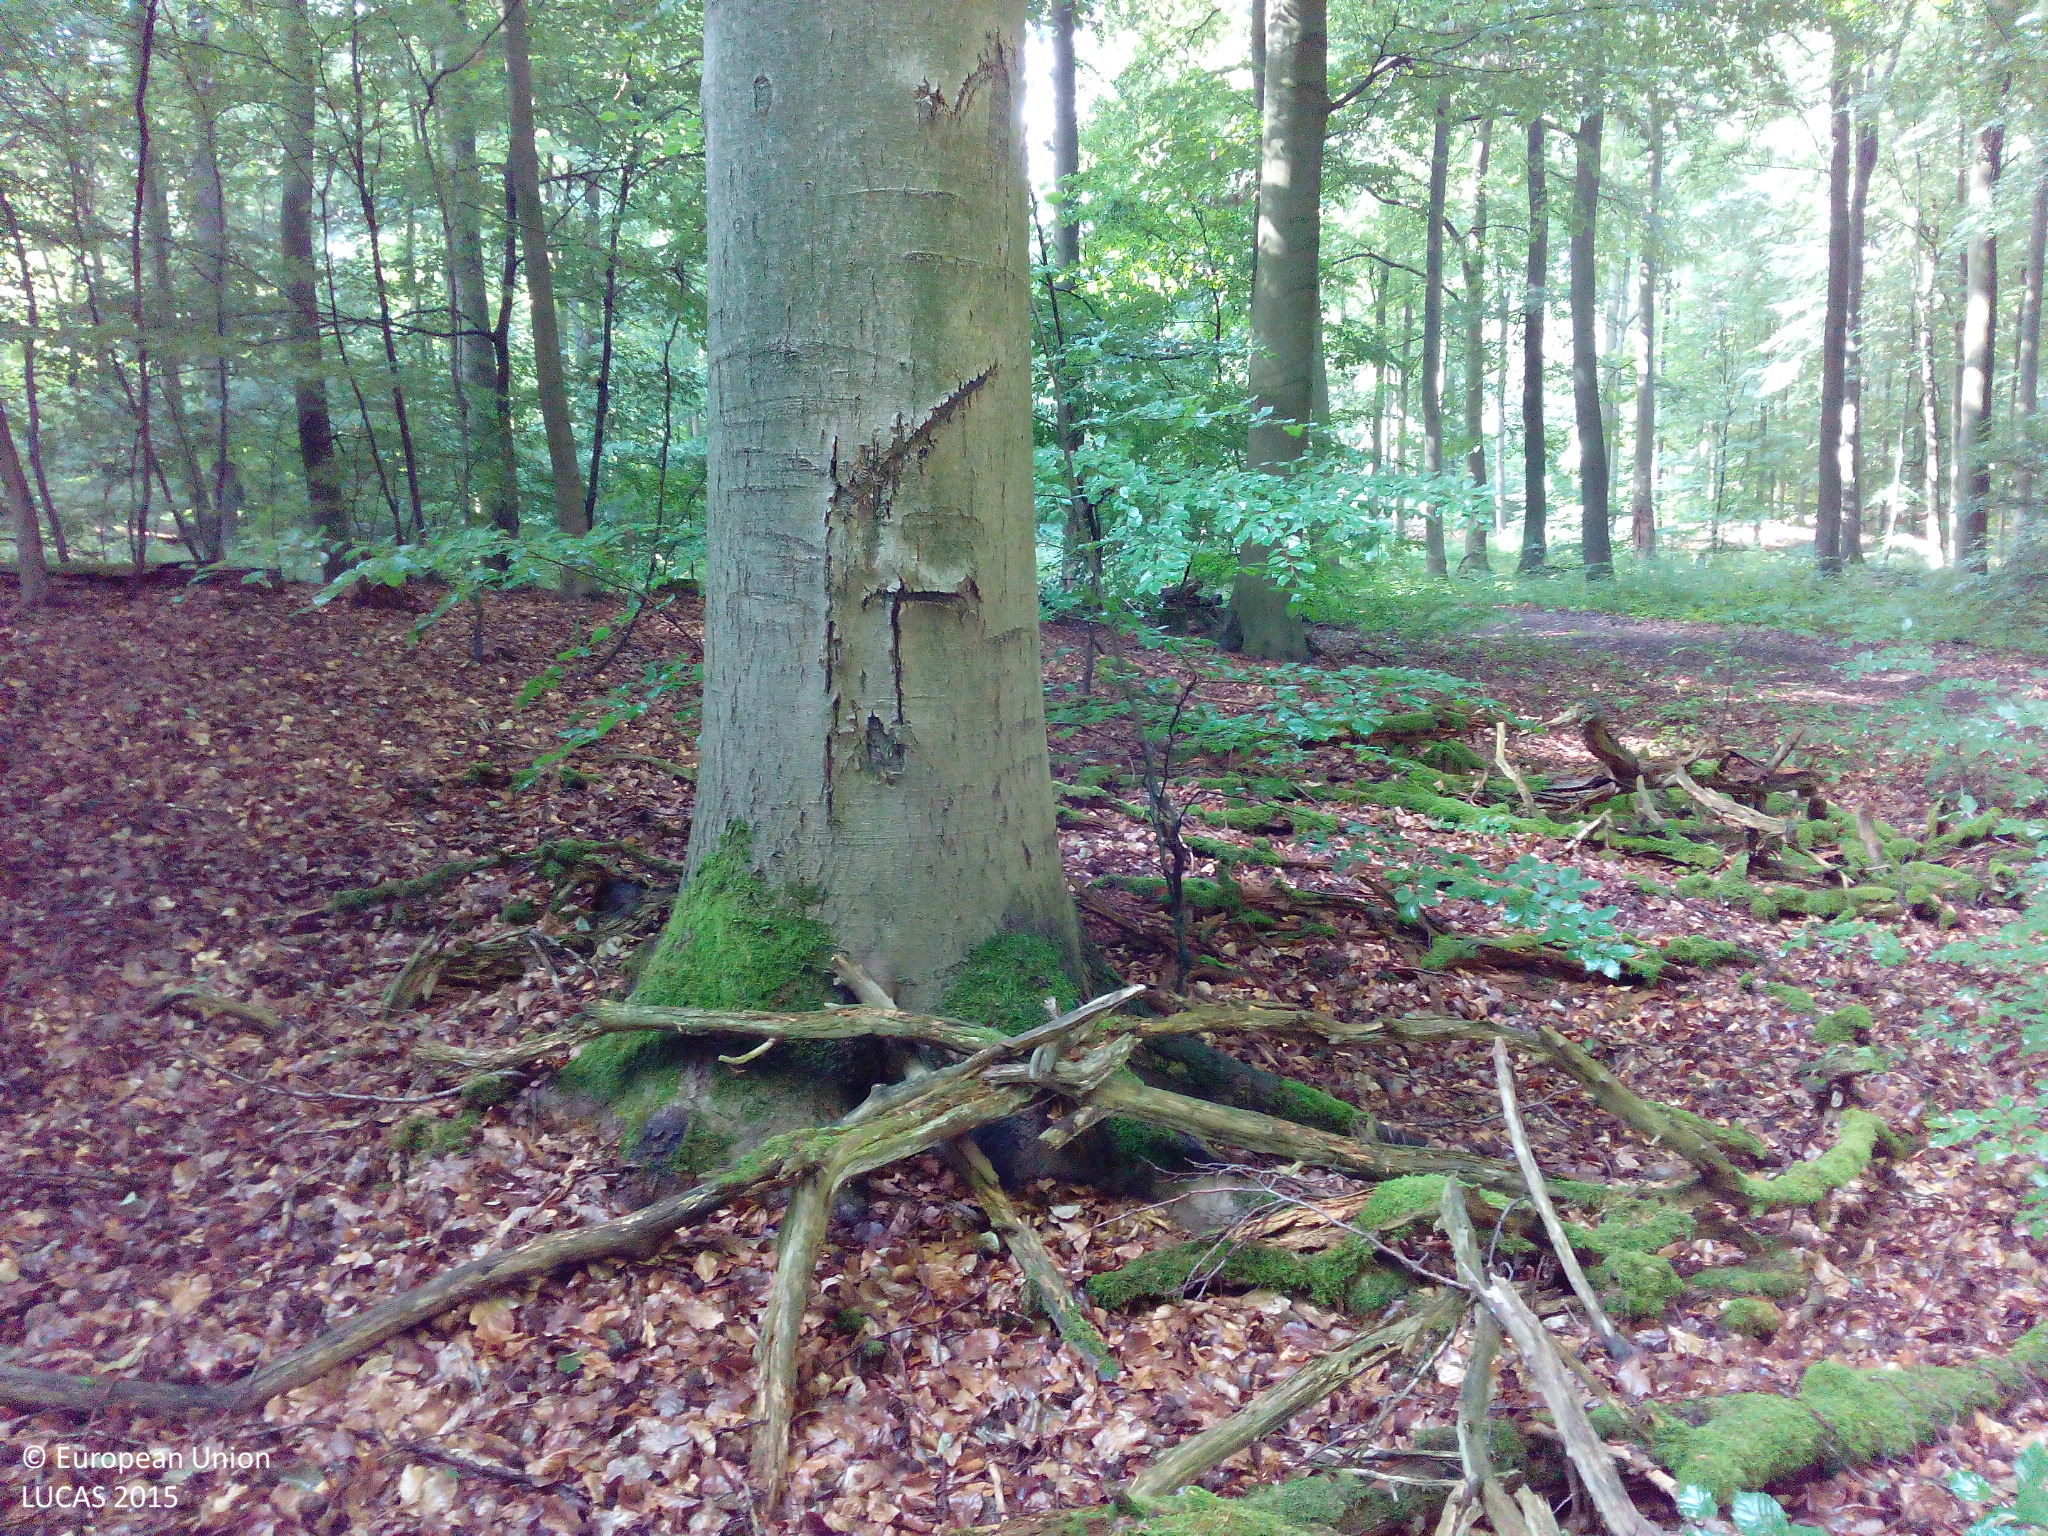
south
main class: Woodland
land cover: Broadleaved woodland
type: beech forest
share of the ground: > 75 %
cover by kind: broadleaved forest trees 90 %, unconsolidated bare surface 10 %
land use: Forestry
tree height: > 5 m
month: July
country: DE
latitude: 52.7744
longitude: 13.5429
